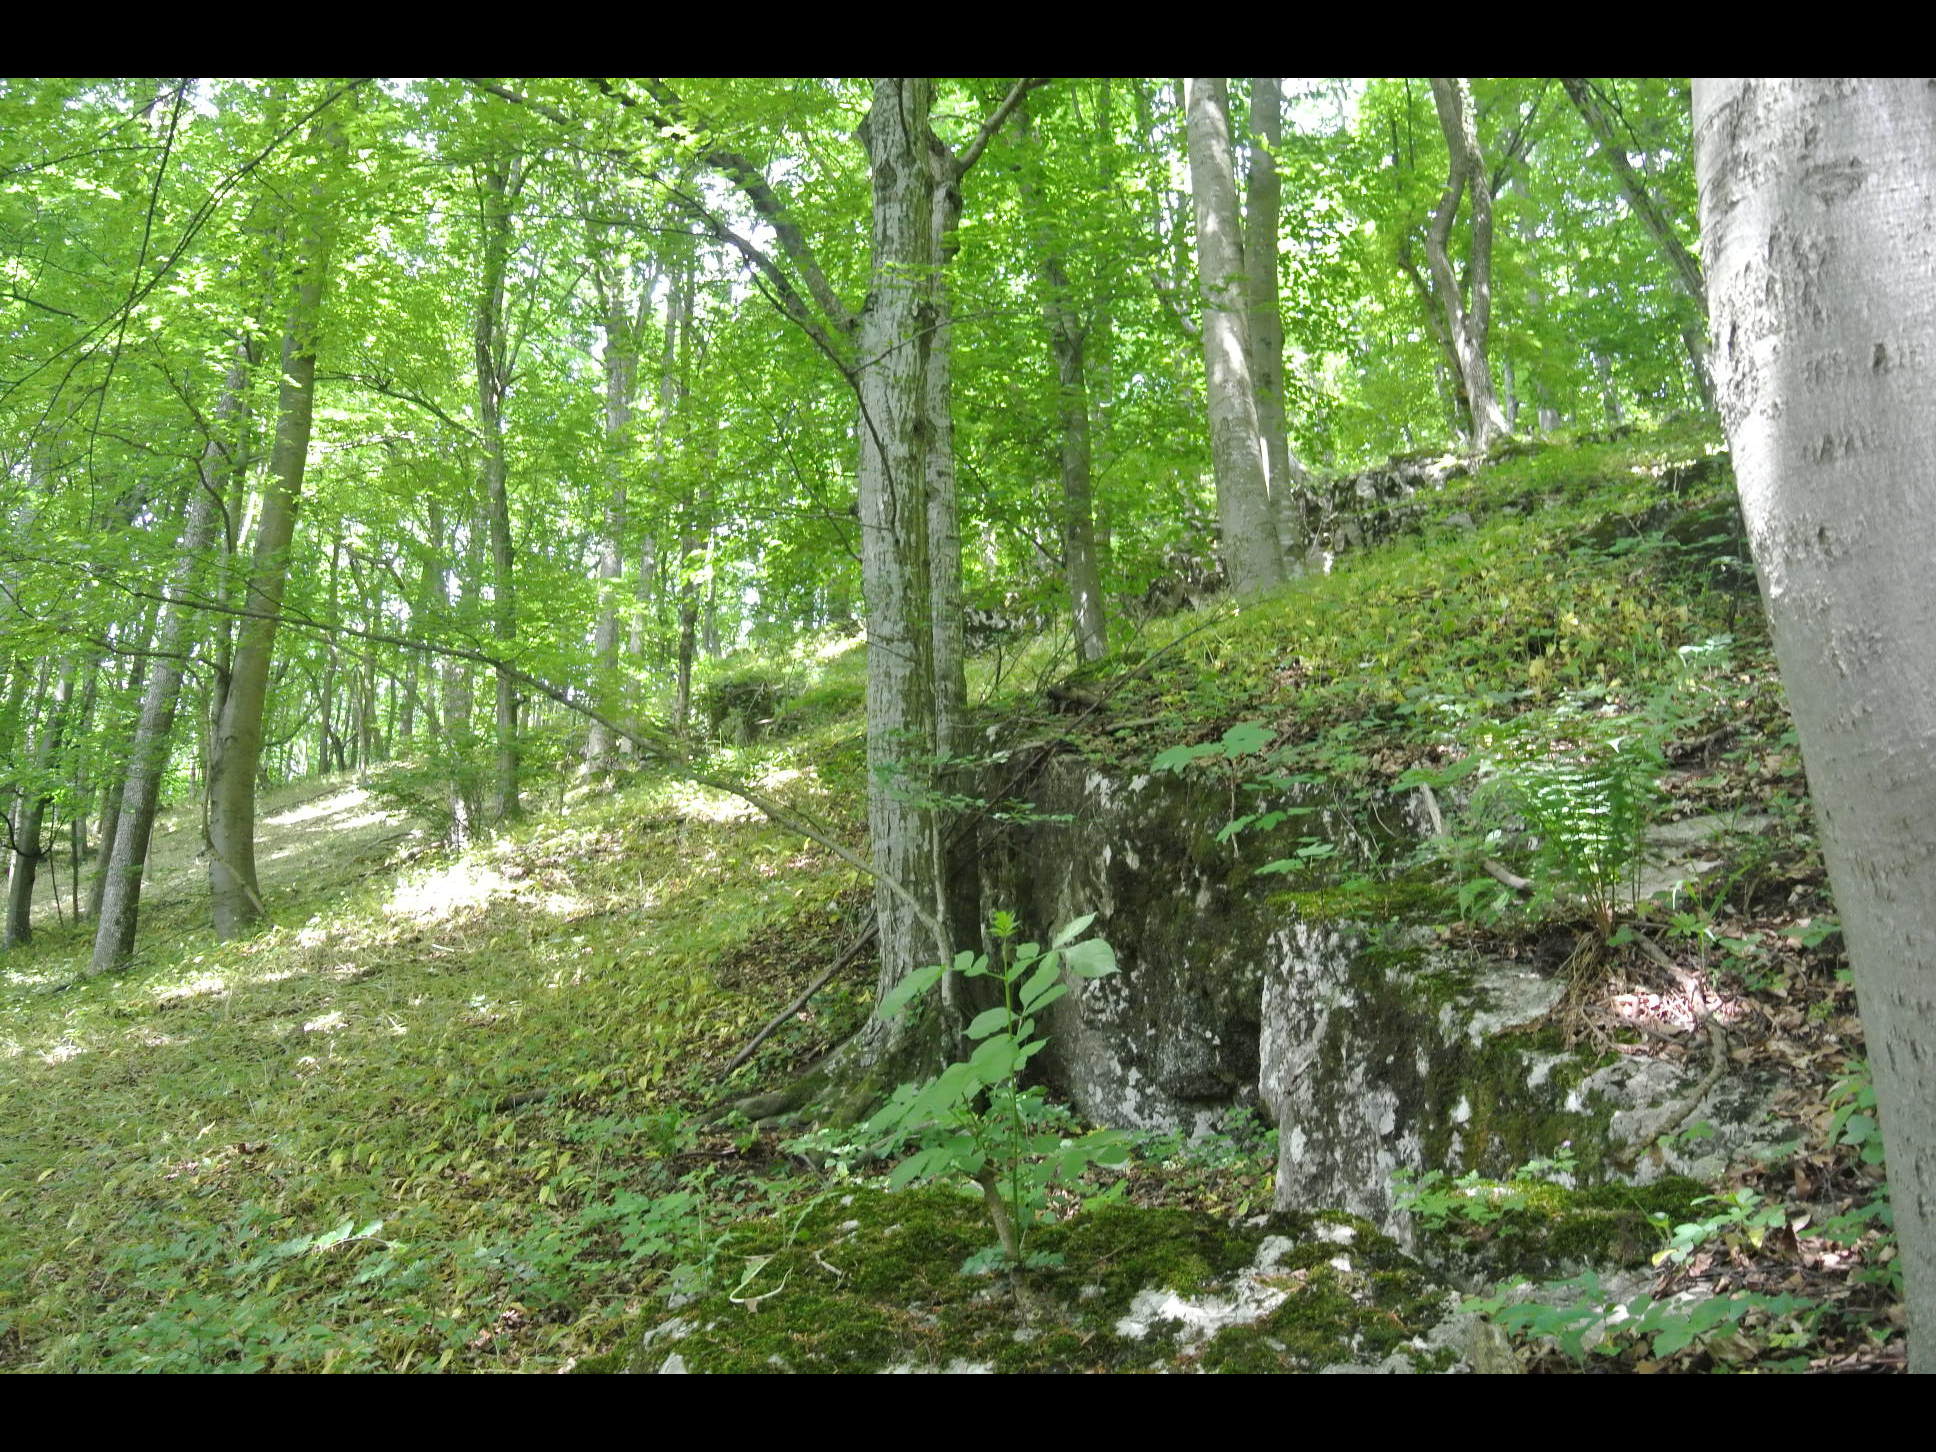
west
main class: Woodland
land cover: Broadleaved woodland
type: beech forest
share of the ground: > 75 %
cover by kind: broadleaved forest trees 100 %
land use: Forestry
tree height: > 5 m
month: June
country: AT
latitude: 48.0033
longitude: 16.0484
